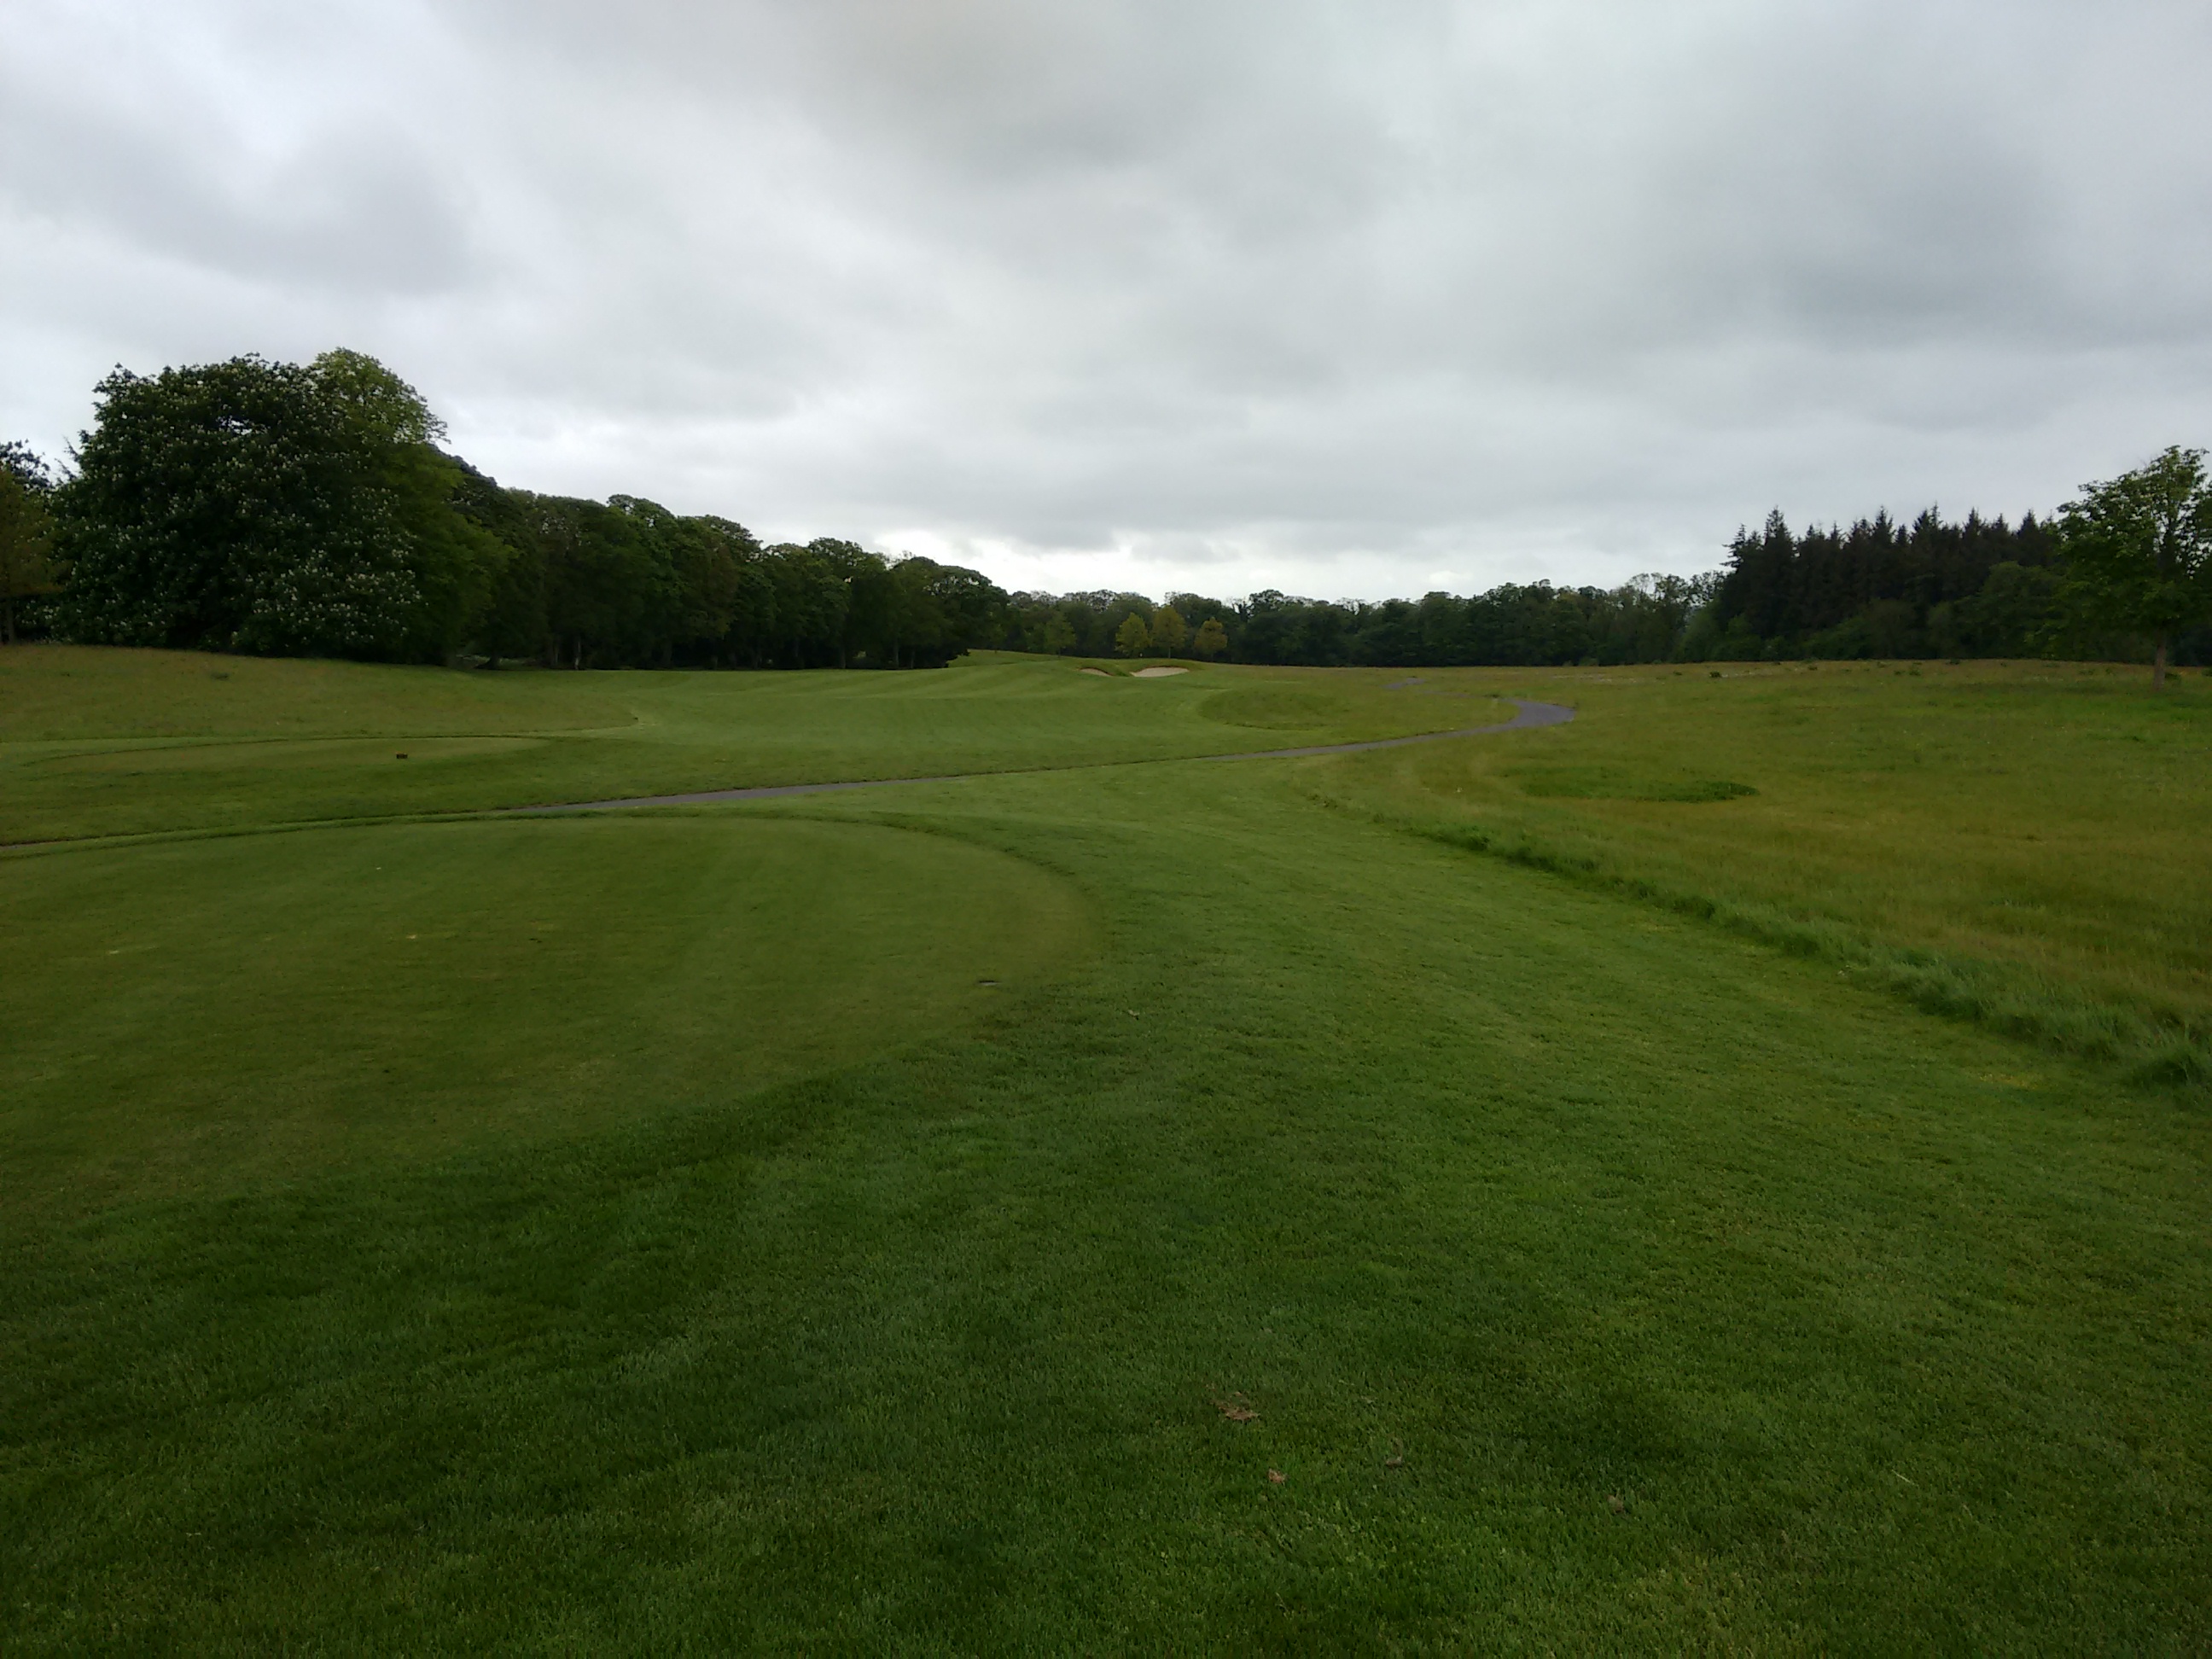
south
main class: Grassland
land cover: Grassland without tree/shrub cover
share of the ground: > 75 %
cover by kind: herbaceous plants 100 %
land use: Sport
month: May
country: IE
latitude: 53.5327
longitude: -6.5892
